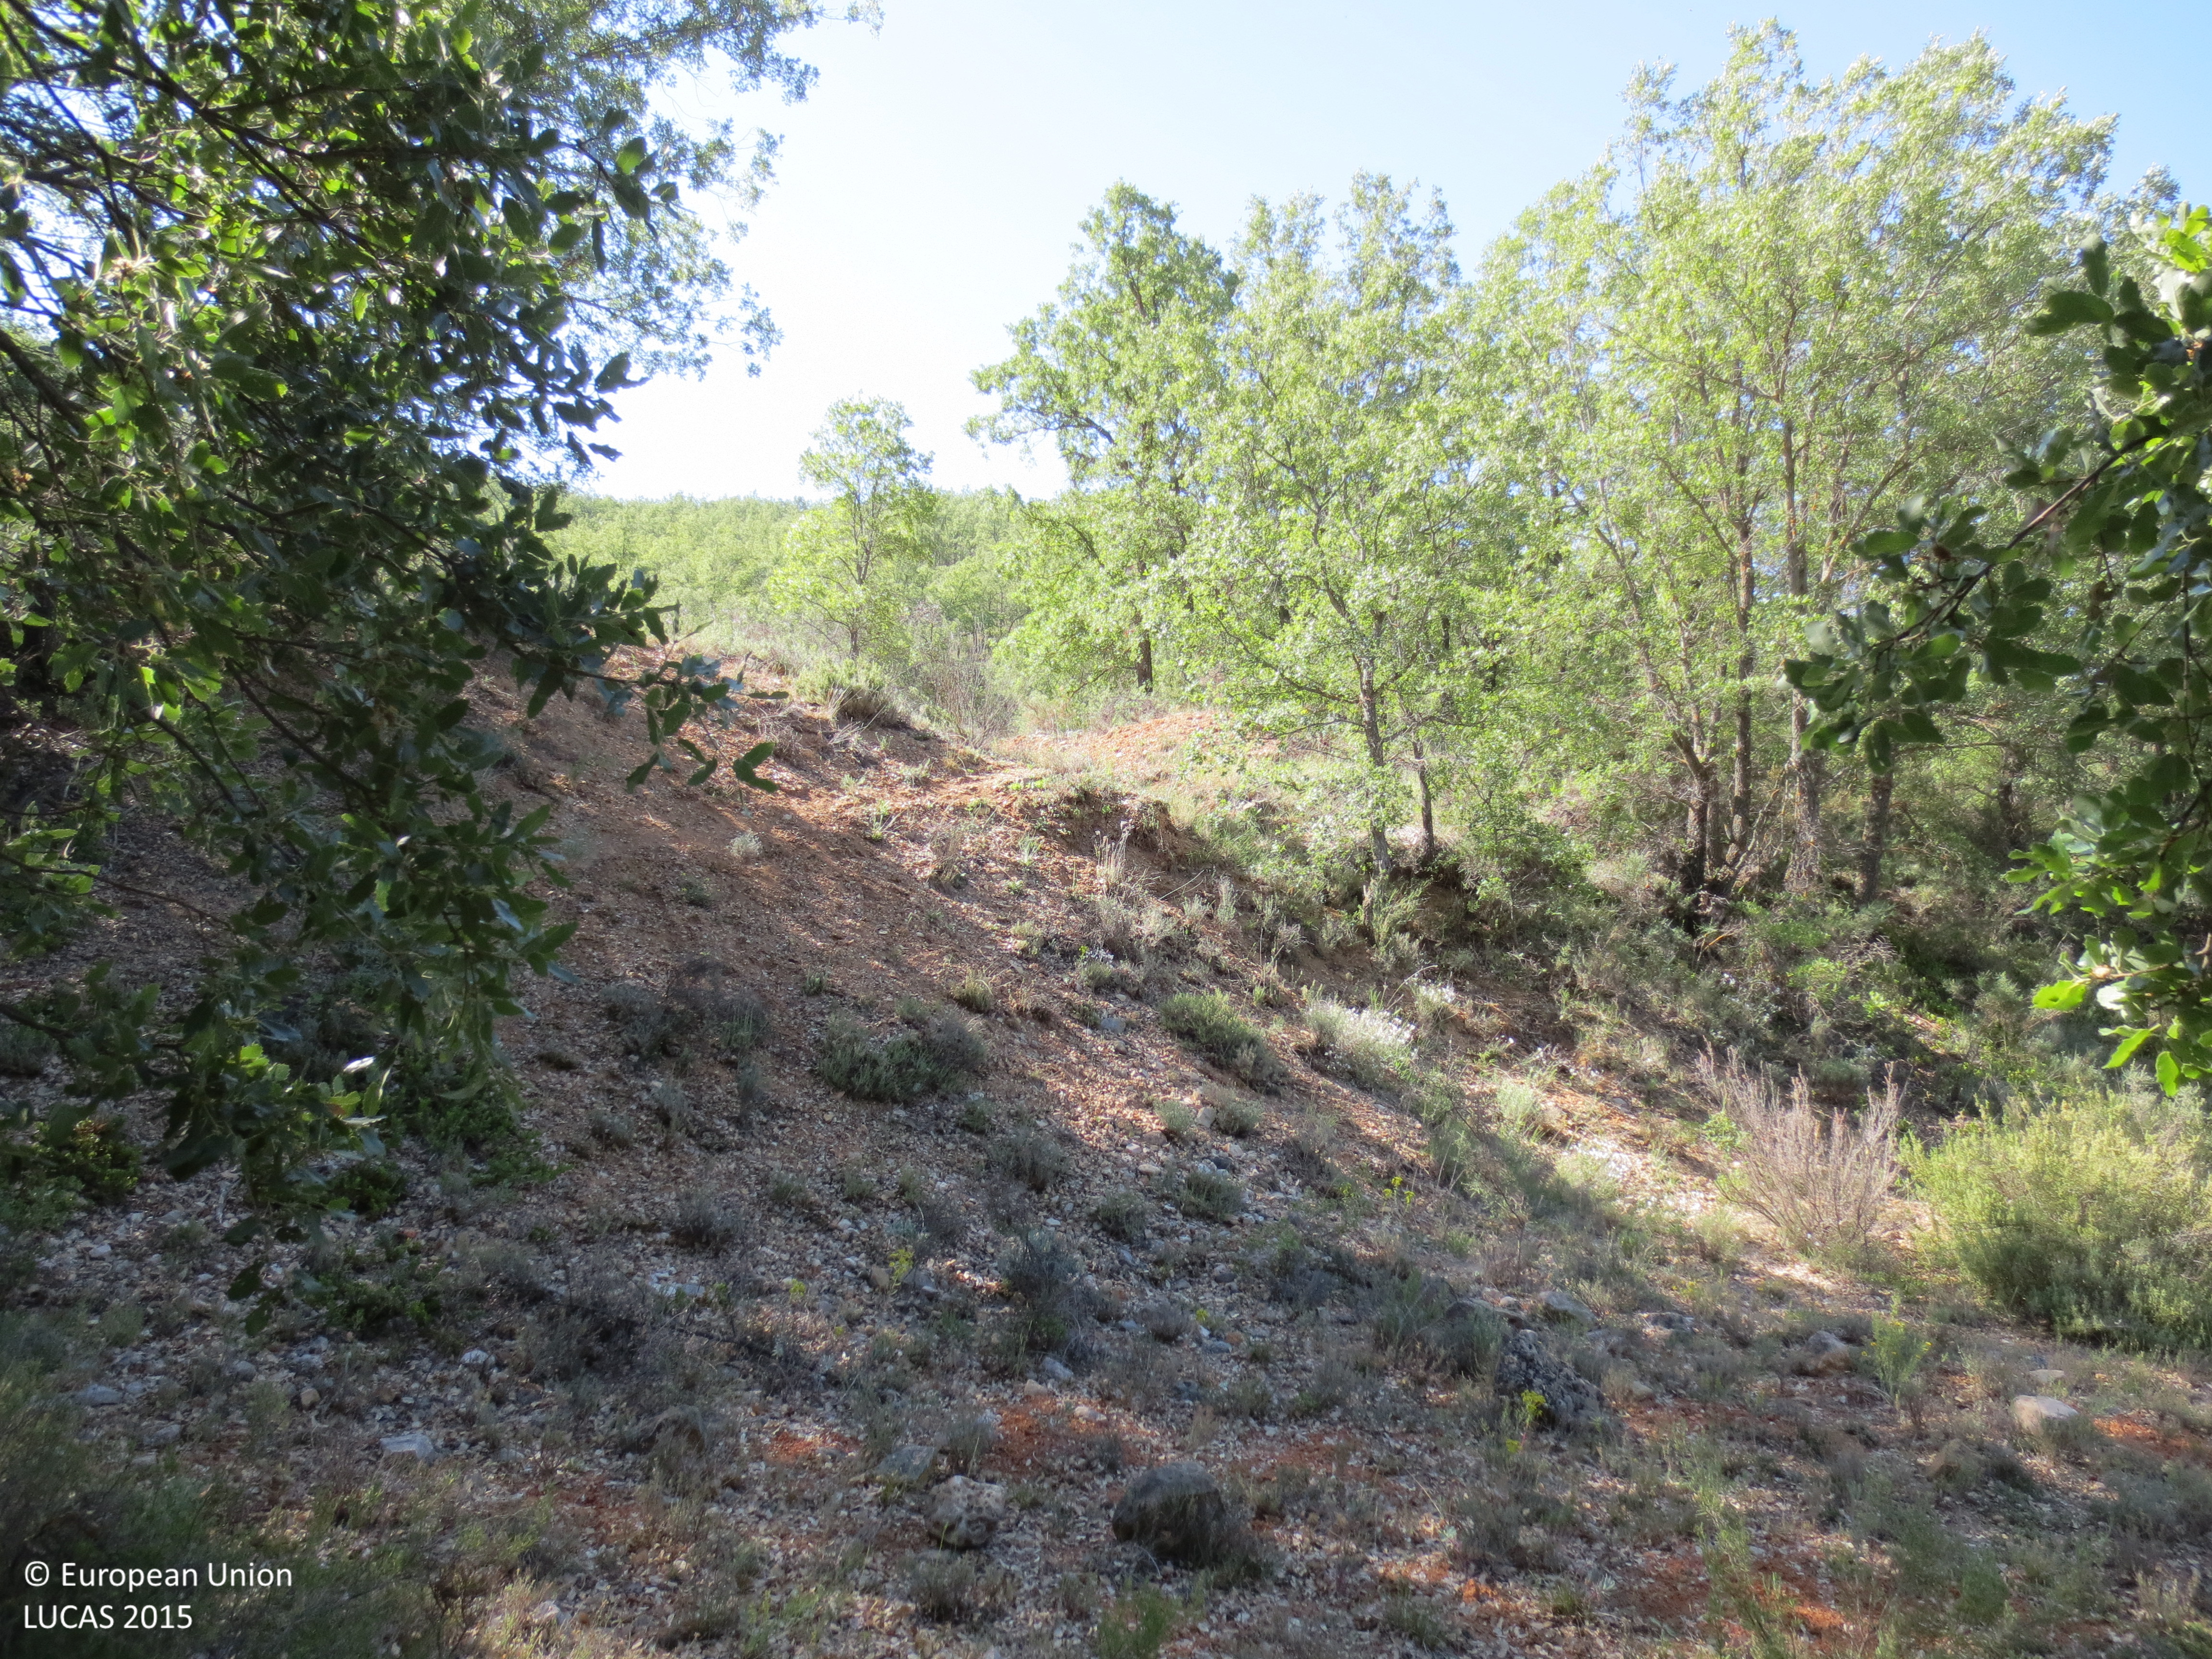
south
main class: Woodland
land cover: Broadleaved woodland
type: thermophilous deciduous forest
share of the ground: 25 - 50 %
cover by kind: broadleaved forest trees 45 %, shrubs 20 %, herbaceous plants 20 %, consolidated bare surface 10 %, coniferous forest trees 5 %
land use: Semi-natural and natural areas not in use
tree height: < 5 m
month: May
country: ES
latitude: 40.6434
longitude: -2.5731
